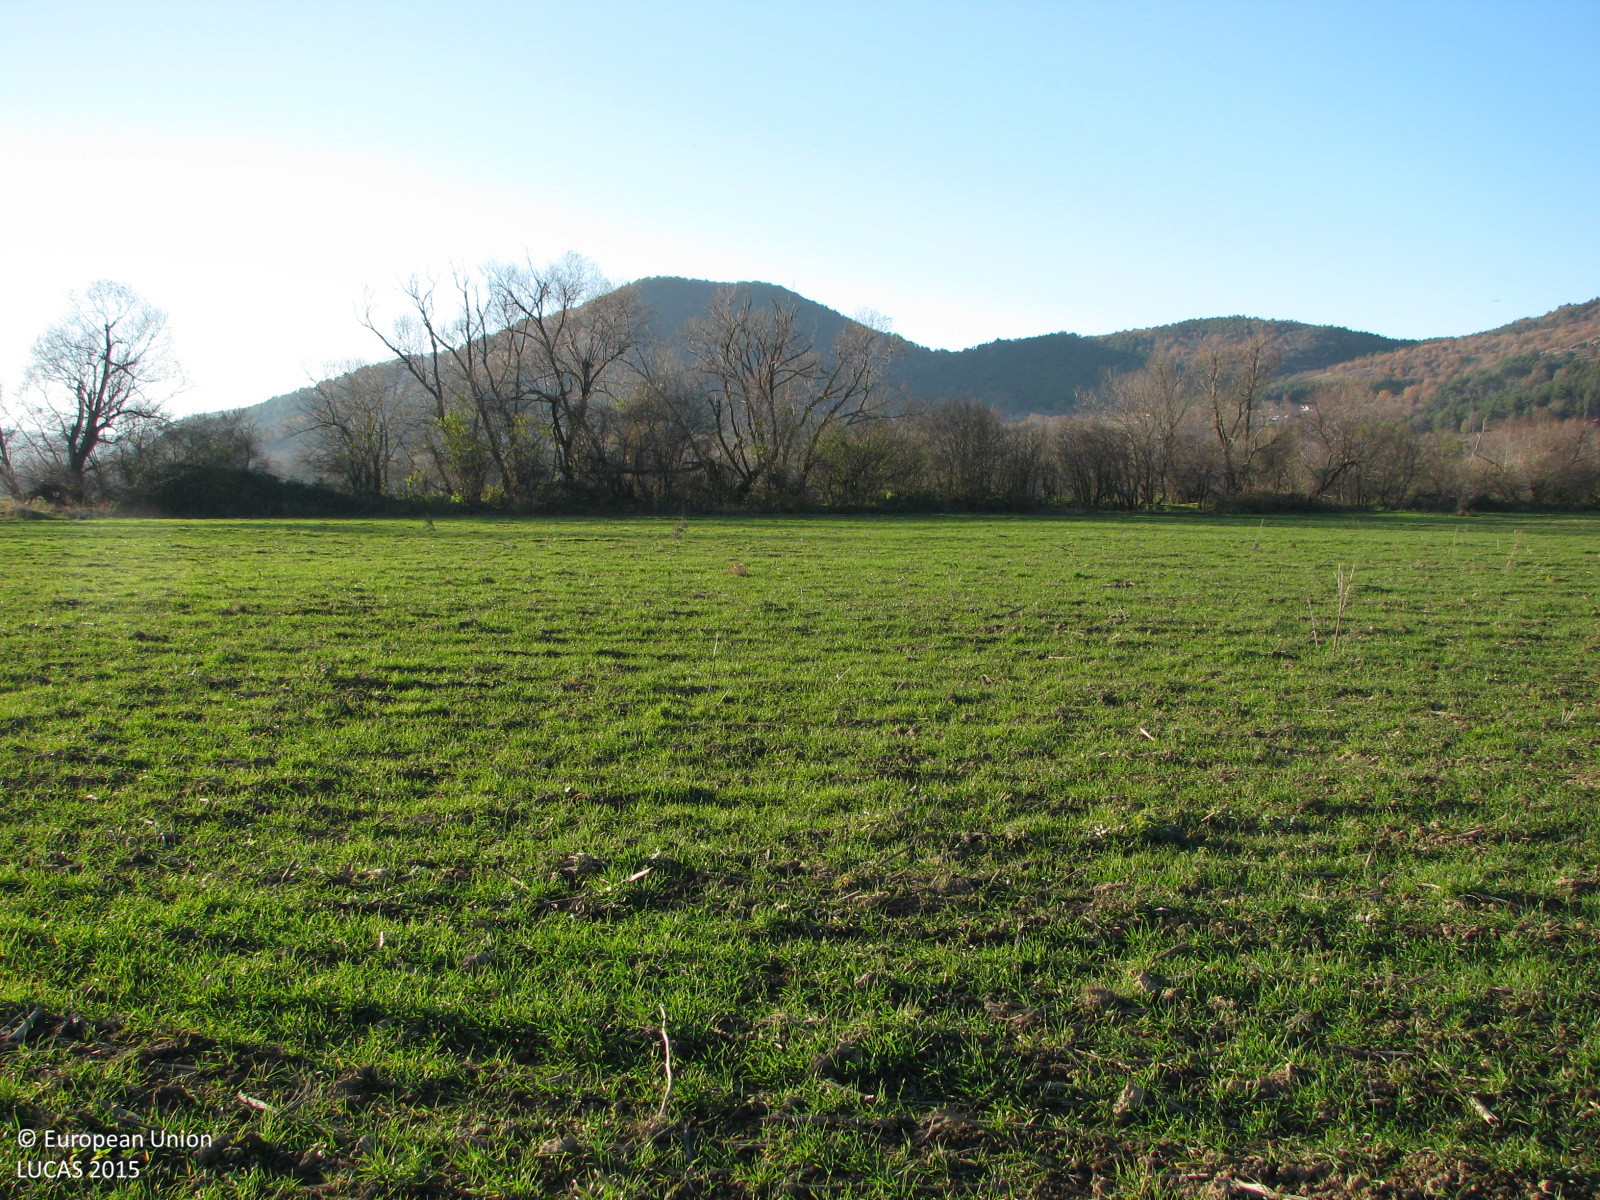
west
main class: Cropland
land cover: Common wheat
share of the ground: > 75 %
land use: Agriculture (excluding fallow land and kitchen gardens)
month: December
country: BG
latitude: 42.4888
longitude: 24.8392
